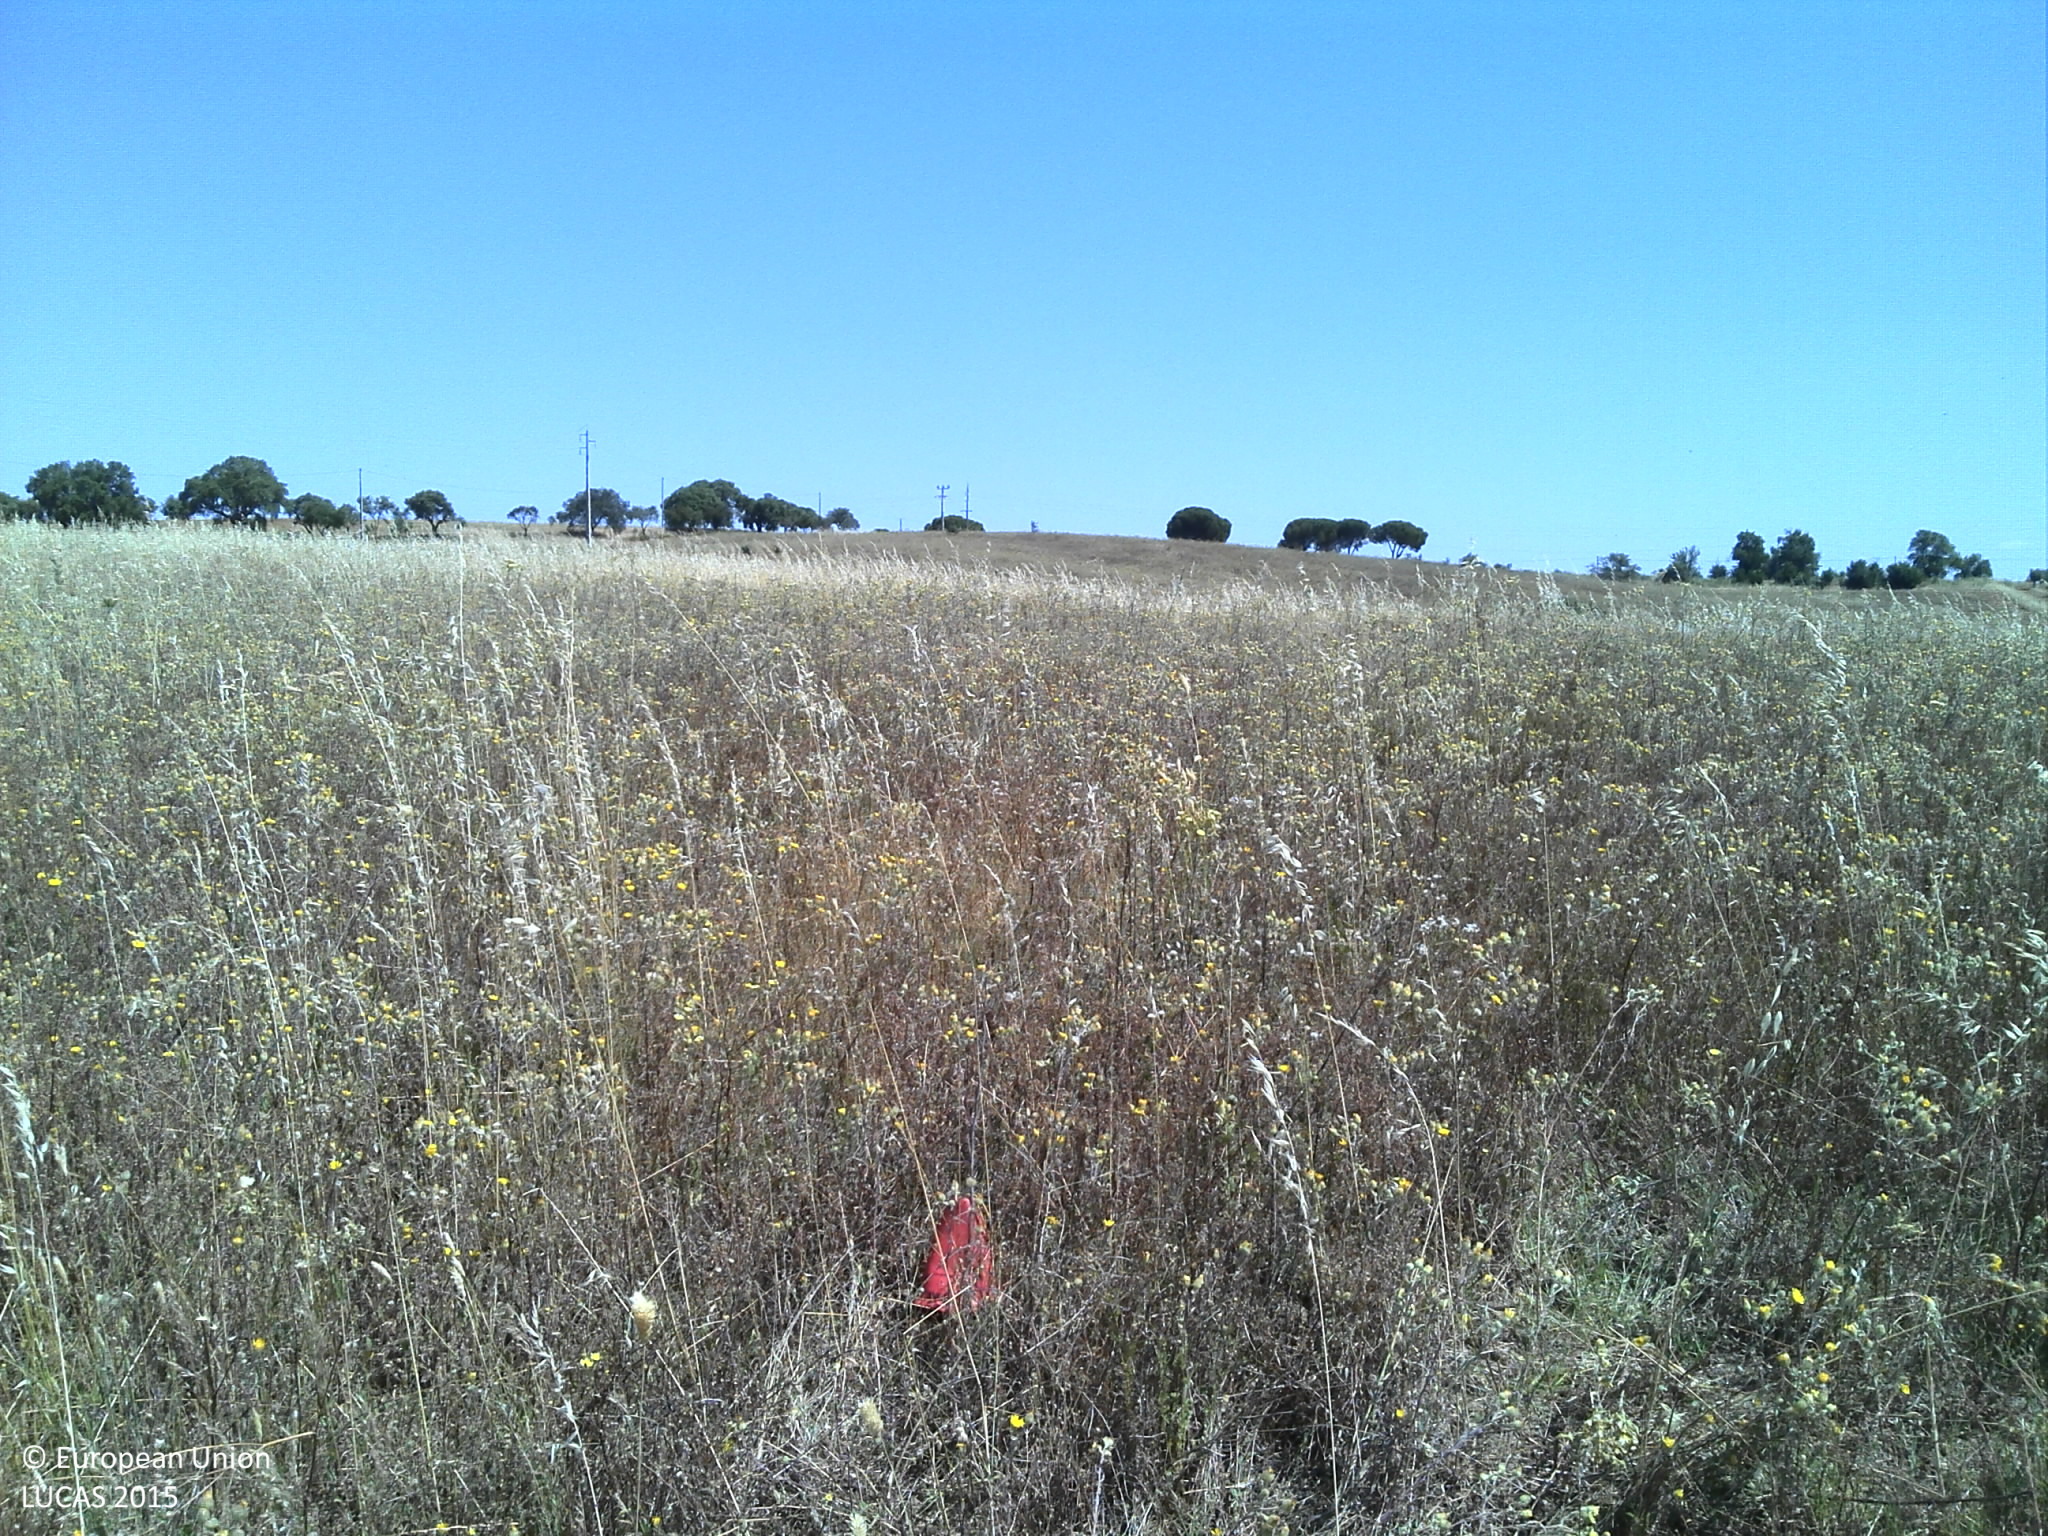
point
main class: Grassland
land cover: Spontaneously vegetated surfaces
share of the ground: > 75 %
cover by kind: herbaceous plants 75 %, unconsolidated bare surface 25 %
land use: Fallow land
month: May
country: PT
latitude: 38.8252
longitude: -7.8149
